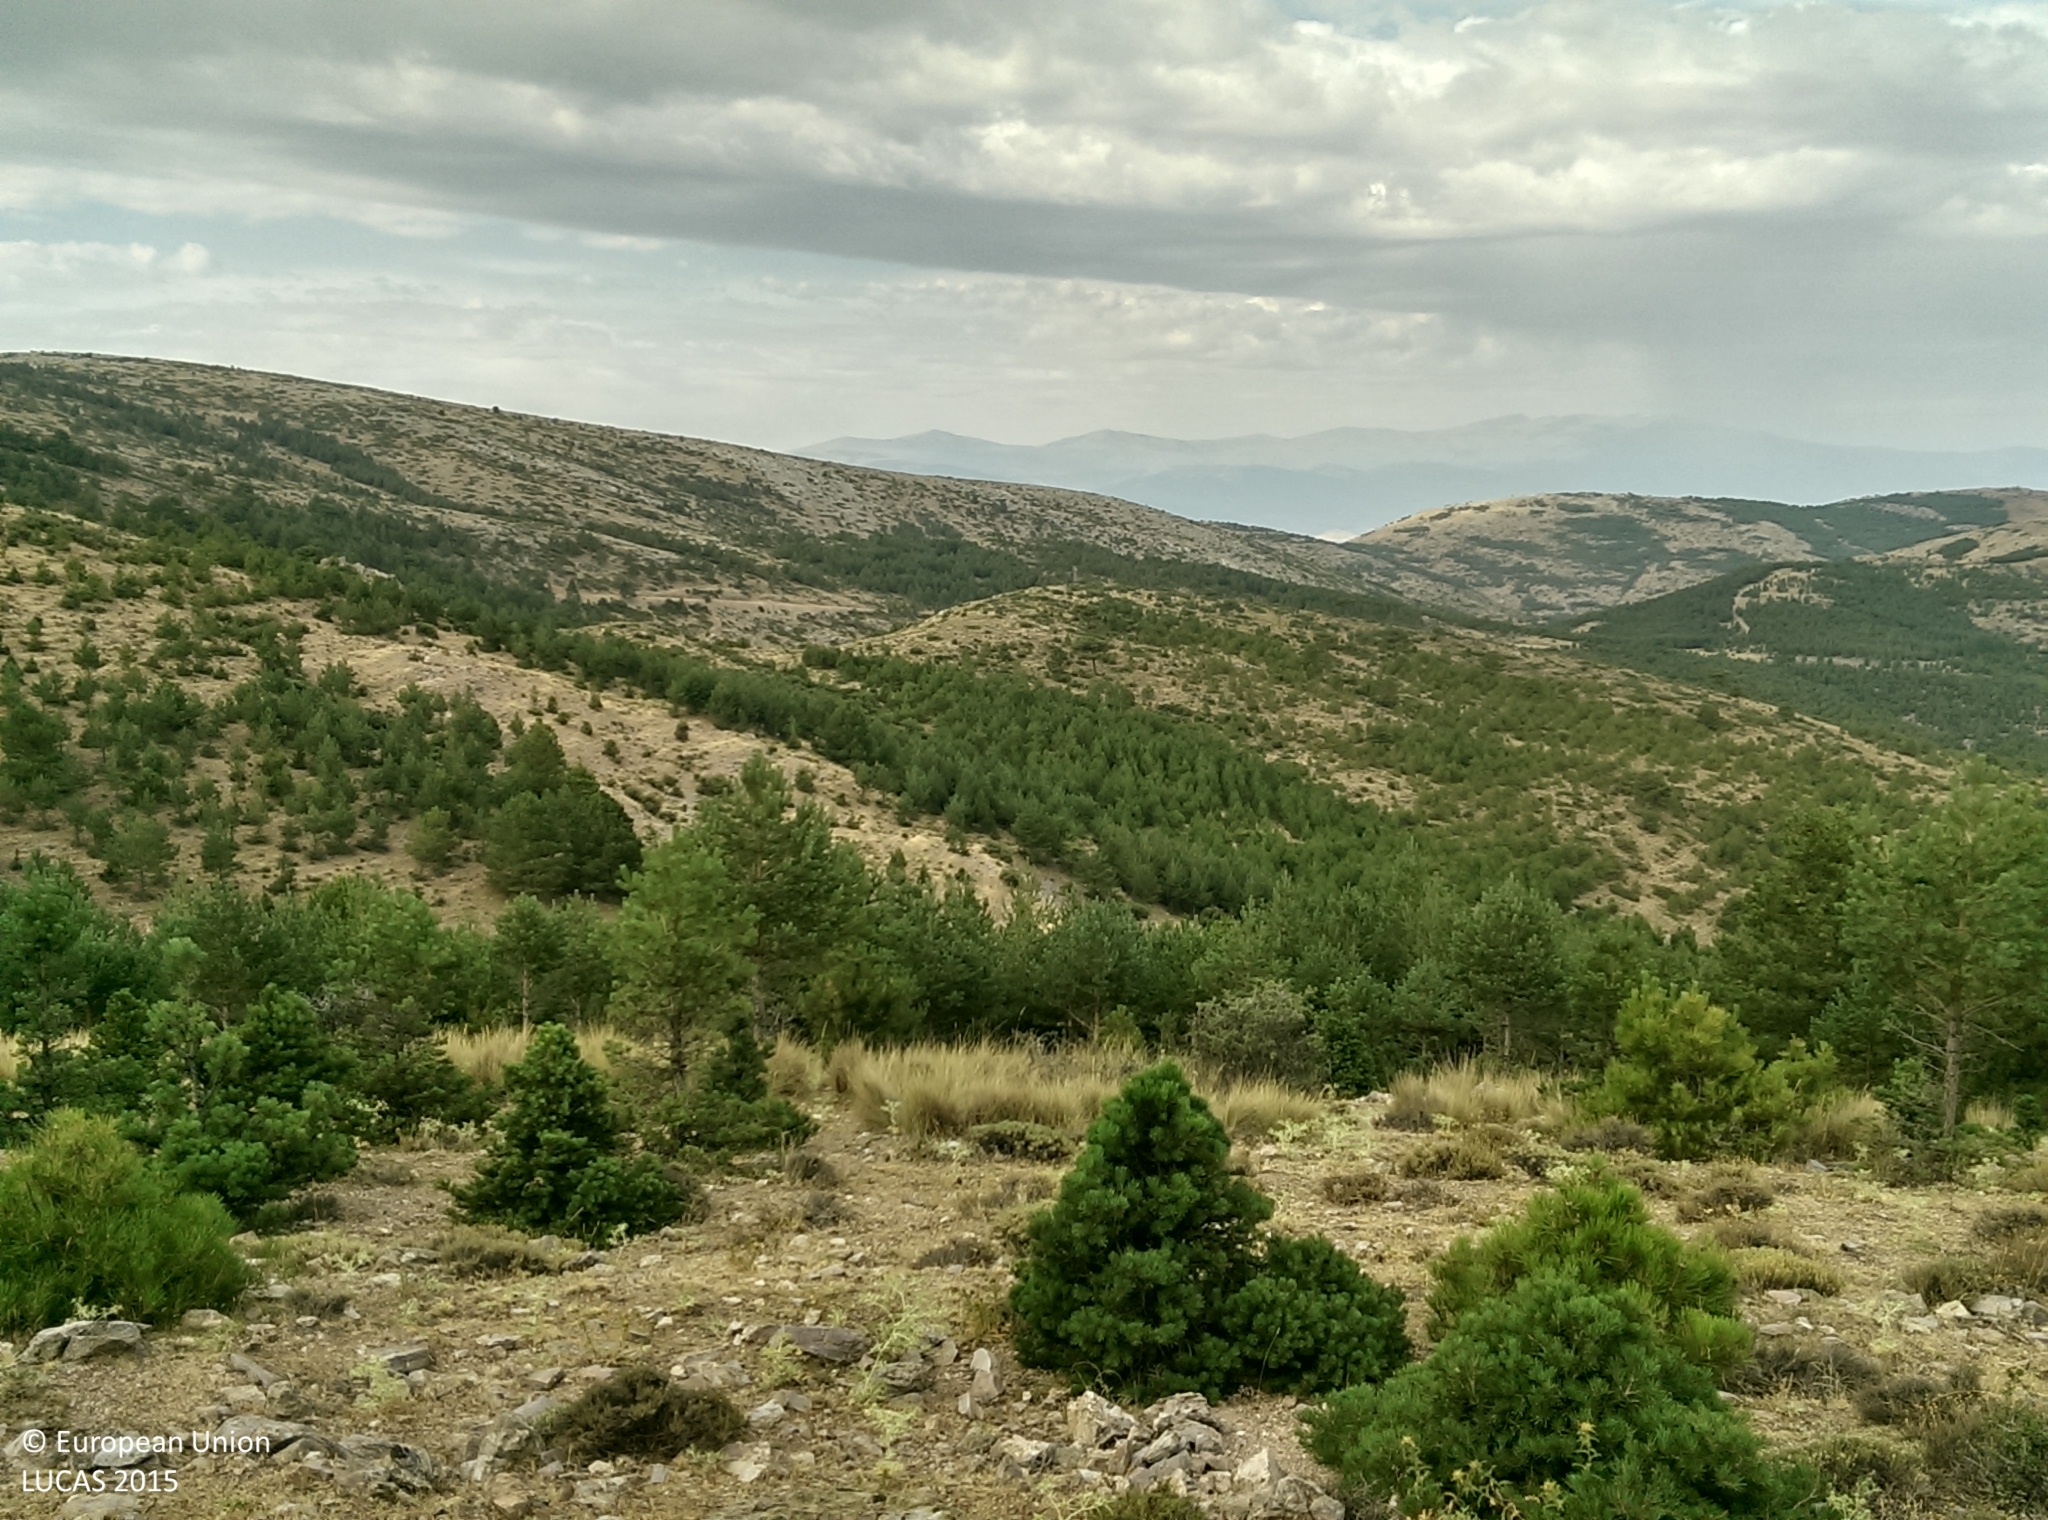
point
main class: Woodland
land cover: Pine dominated coniferous woodland
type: alpine coniferous forest
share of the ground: > 75 %
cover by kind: coniferous forest trees 80 %, shrubs 5 %, herbaceous plants 5 %, consolidated bare surface 5 %, unconsolidated bare surface 5 %
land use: Forestry
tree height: > 5 m
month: July
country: ES
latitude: 37.3286
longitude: -2.8624
